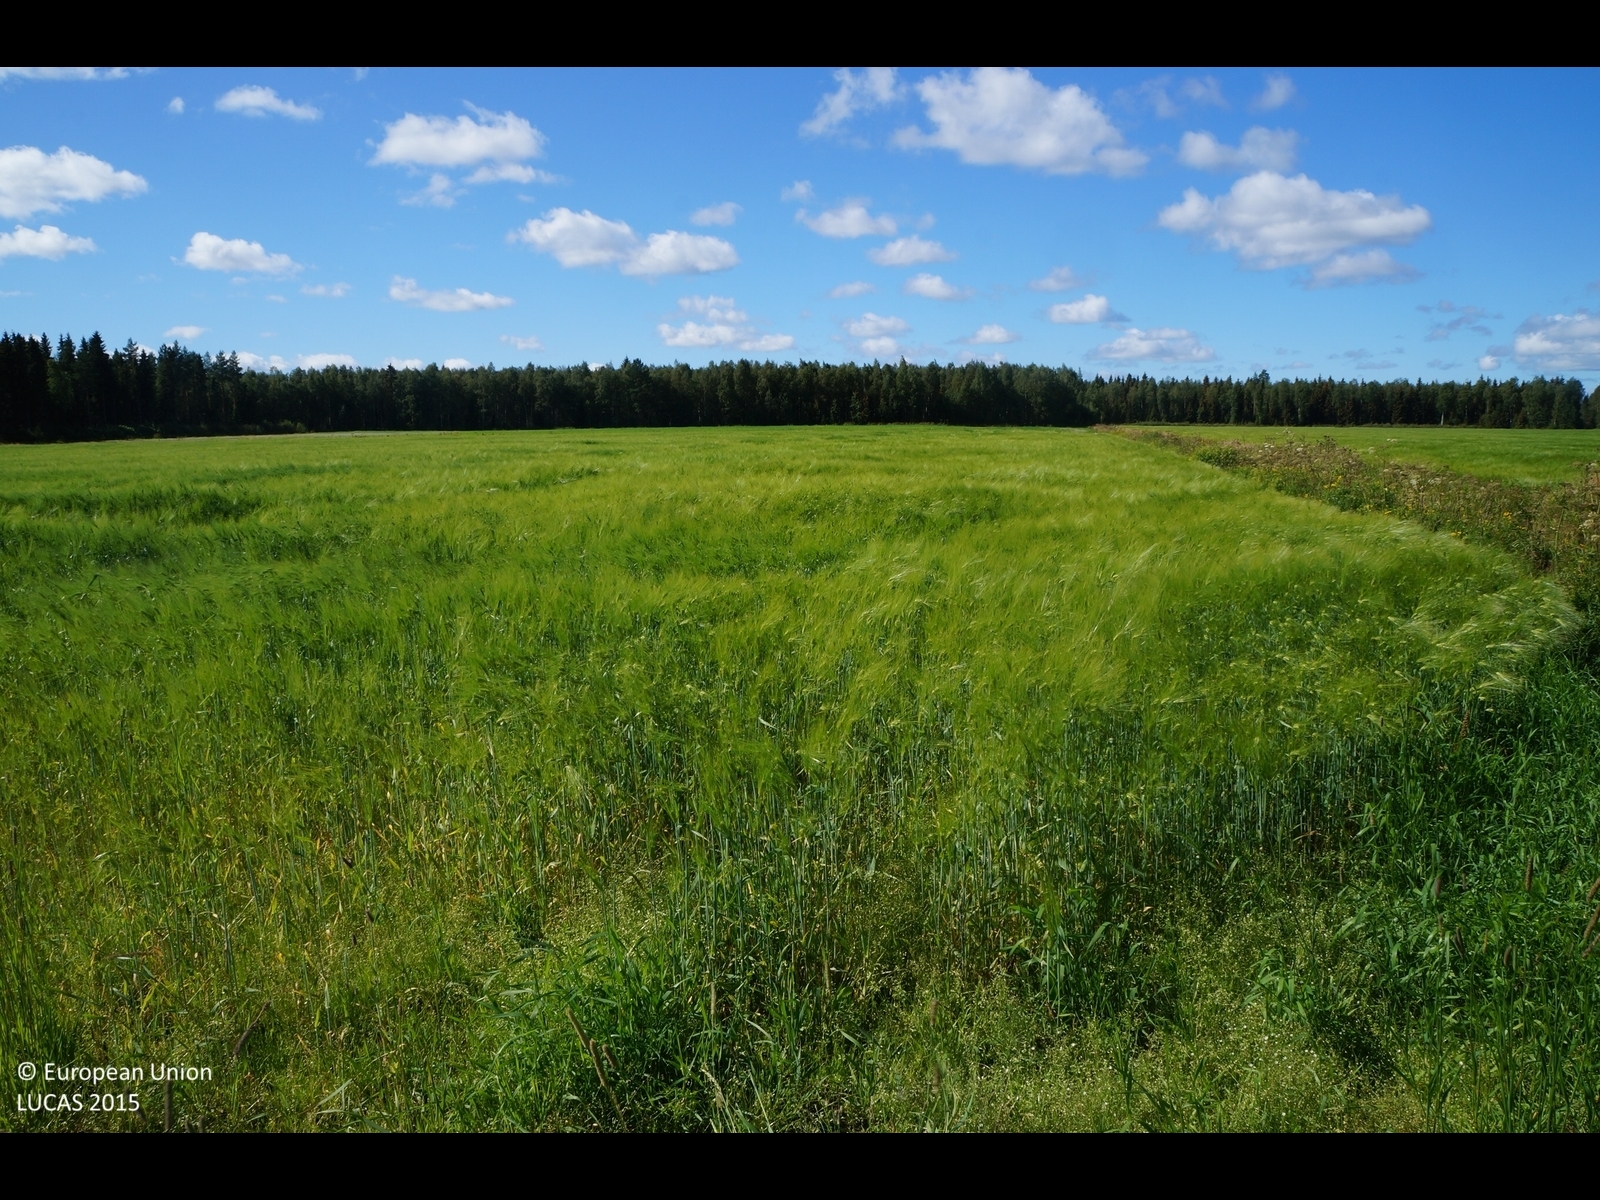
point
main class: Cropland
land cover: Barley
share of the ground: > 75 %
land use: Agriculture (excluding fallow land and kitchen gardens)
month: August
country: FI
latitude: 64.7370
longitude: 25.5229
